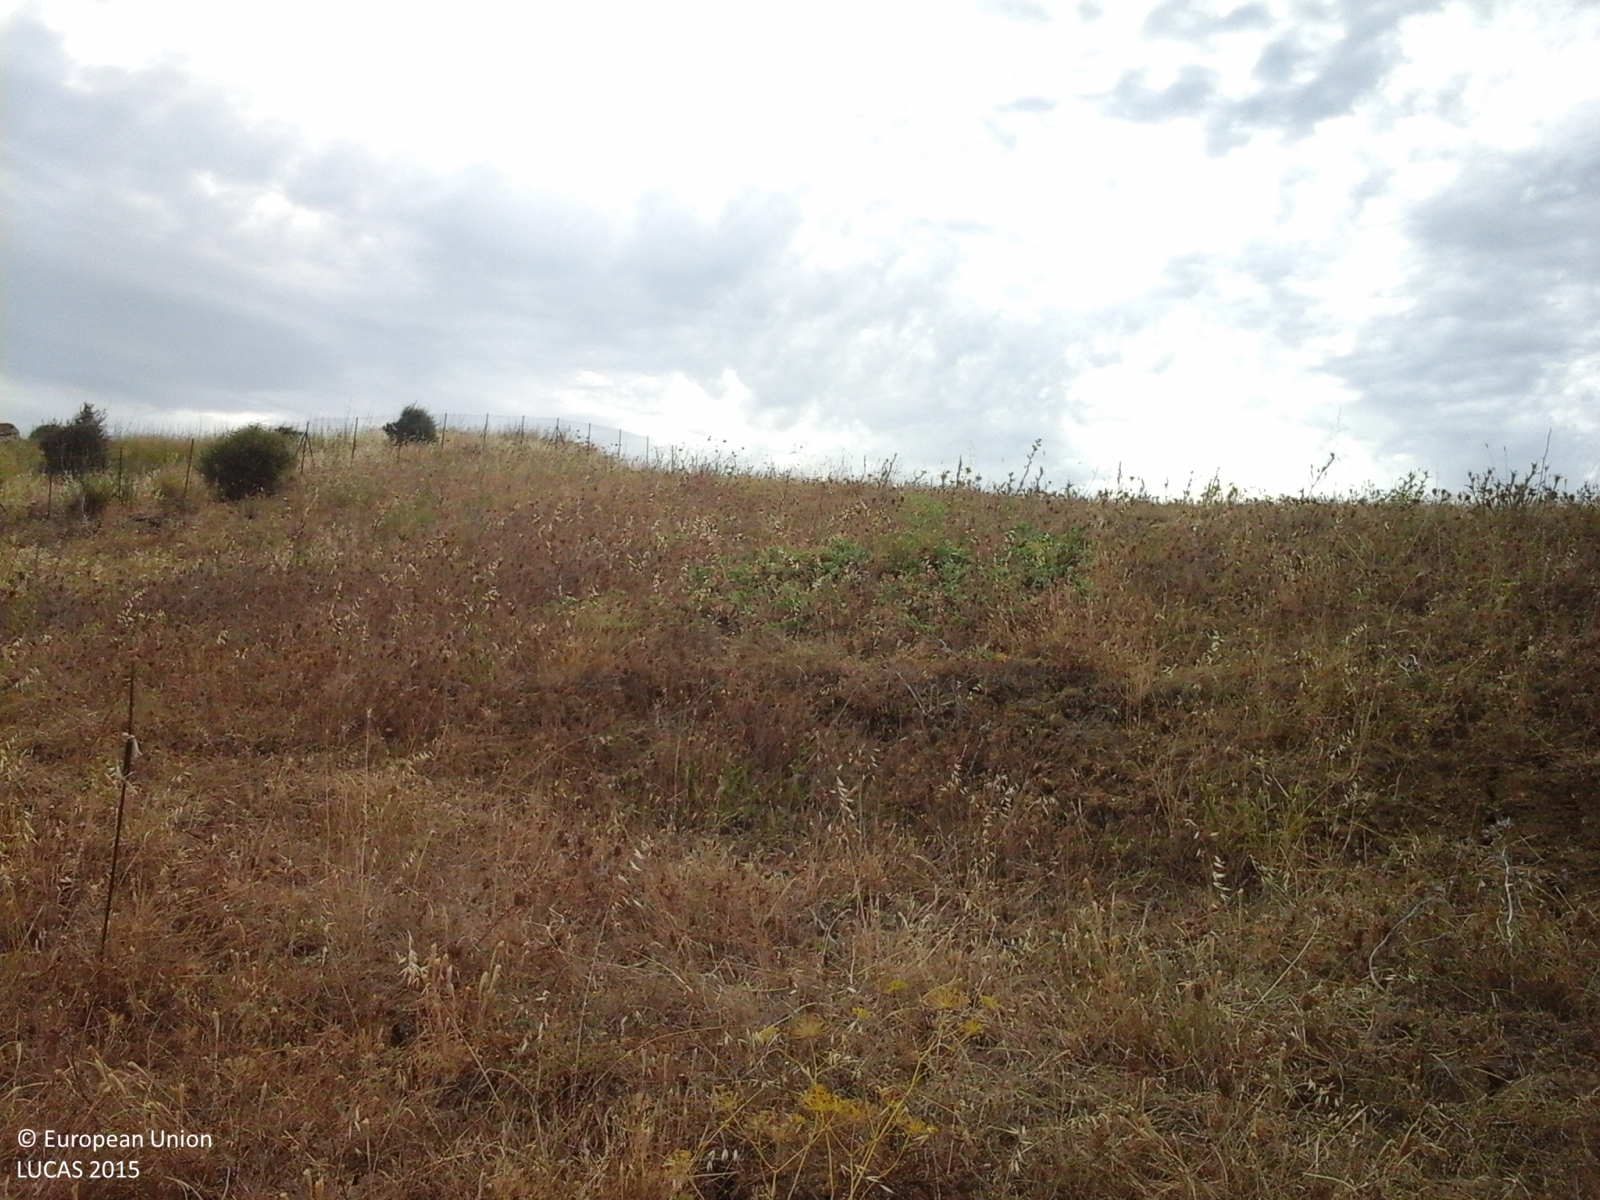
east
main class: Grassland
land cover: Grassland without tree/shrub cover
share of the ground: > 75 %
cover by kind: herbaceous plants 100 %
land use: Agriculture (excluding fallow land and kitchen gardens)
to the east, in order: Grassland without tree/shrub cover; Fences; Tracks; Grass margins; Fences; Grassland without tree/shrub cover; Shrubland without tree cover
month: June
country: IT
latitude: 37.4961
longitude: 13.1317
